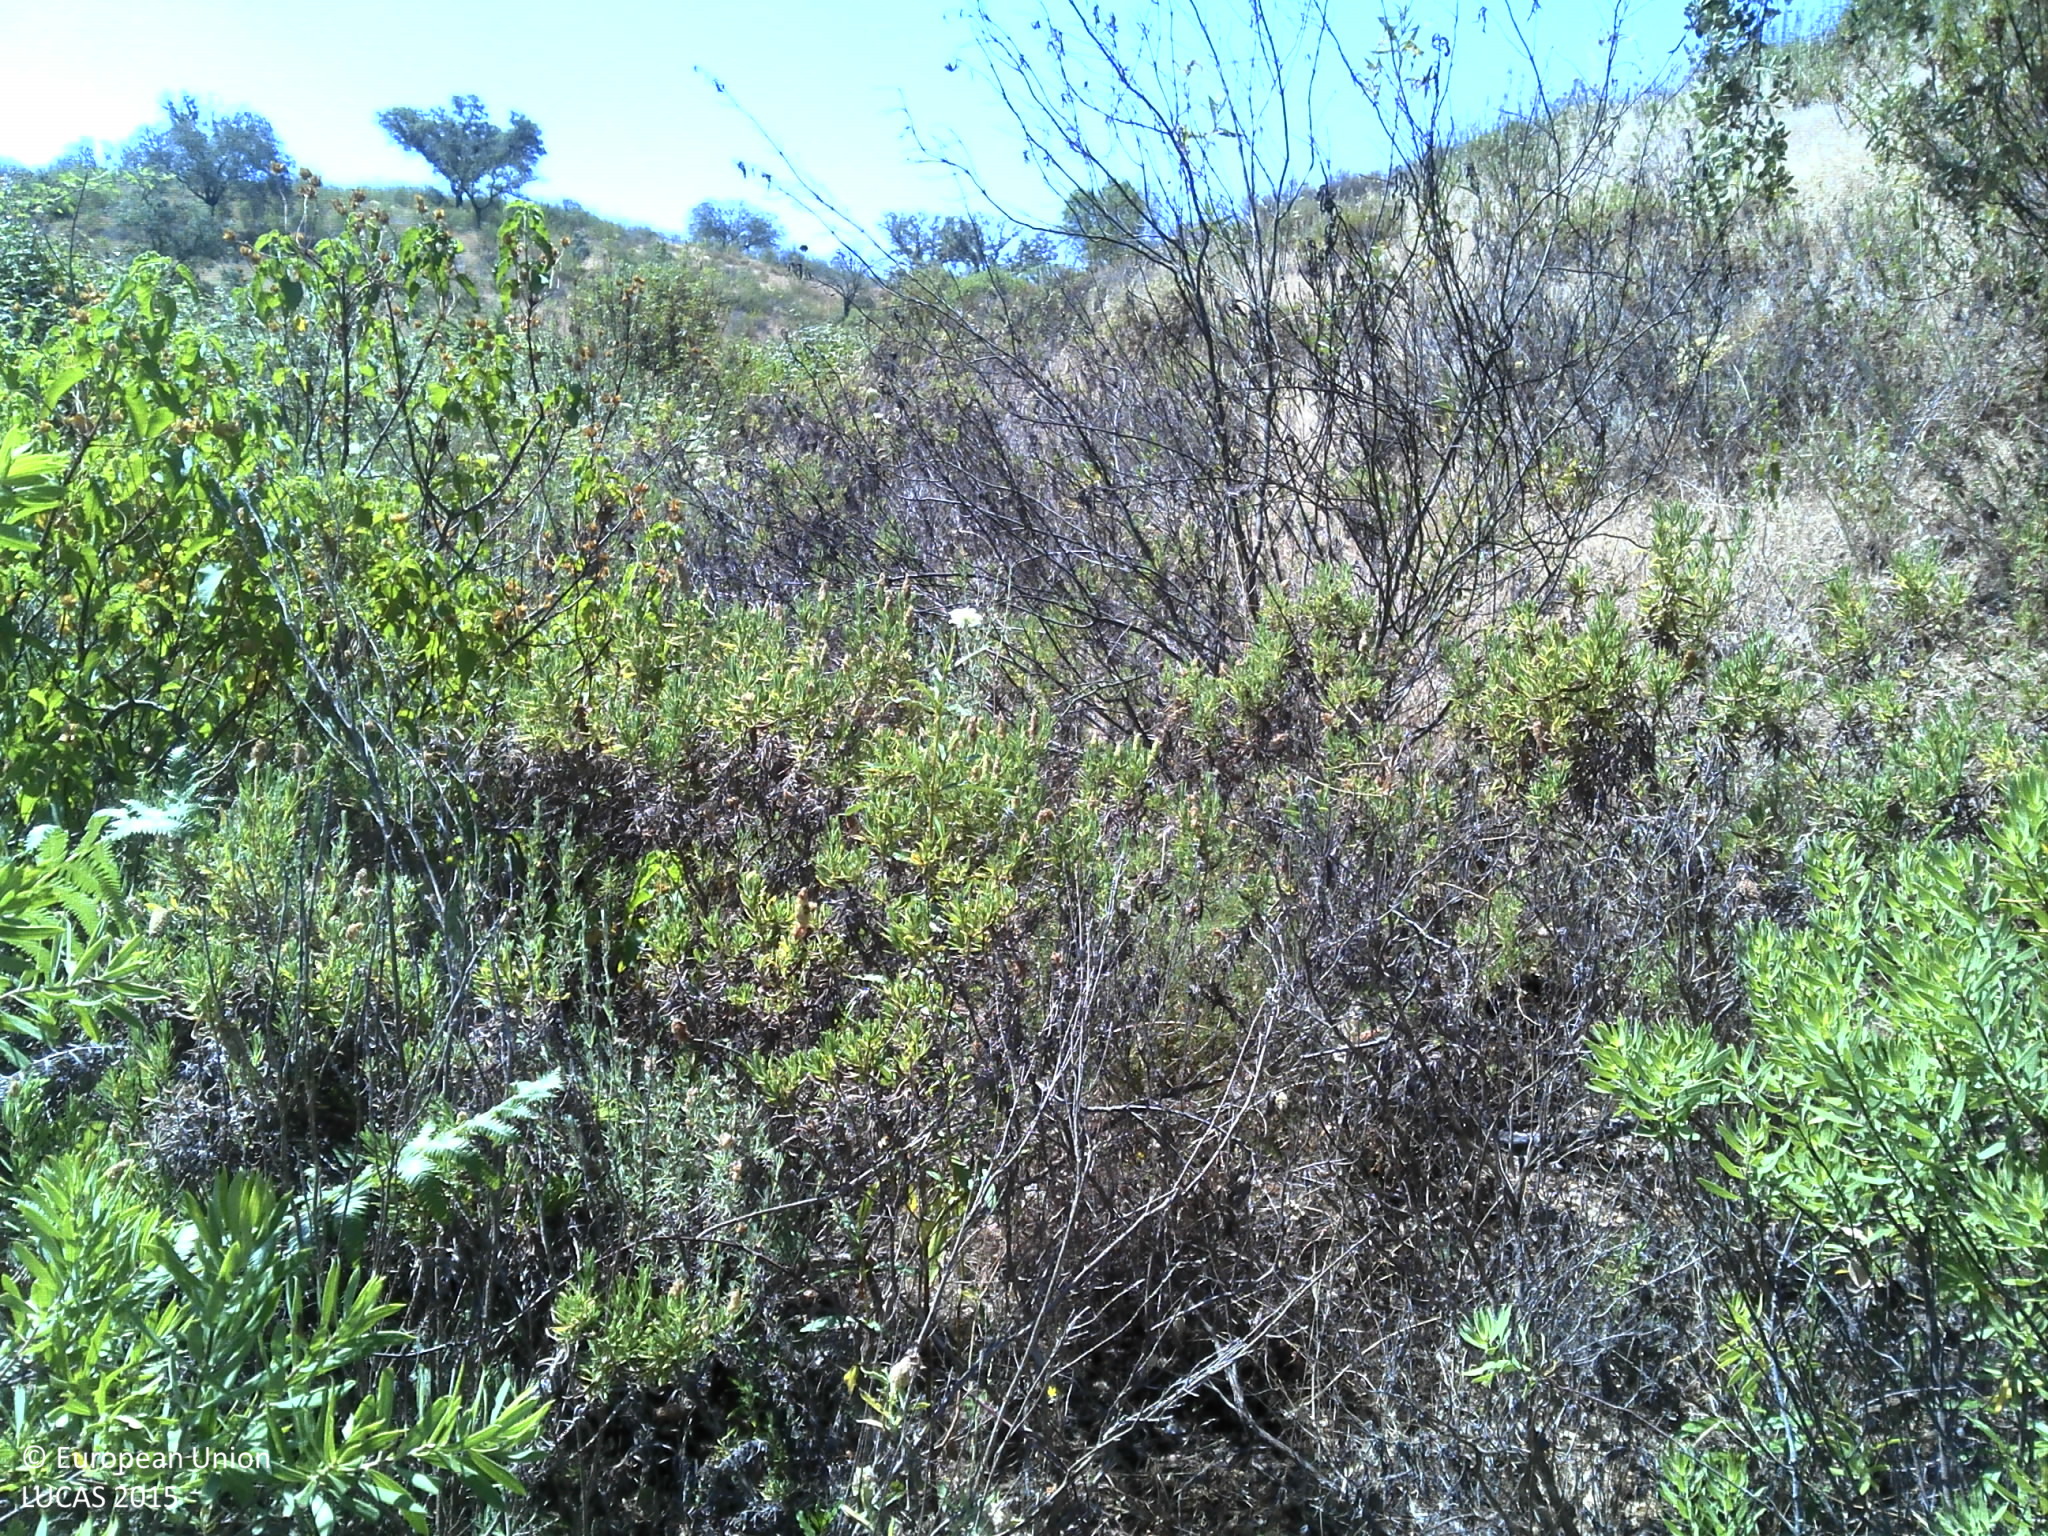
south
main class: Grassland
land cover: Spontaneously vegetated surfaces
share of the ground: > 75 %
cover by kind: herbaceous plants 95 %, shrubs 5 %
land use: Forestry
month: June
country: PT
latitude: 37.8616
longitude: -7.5331
